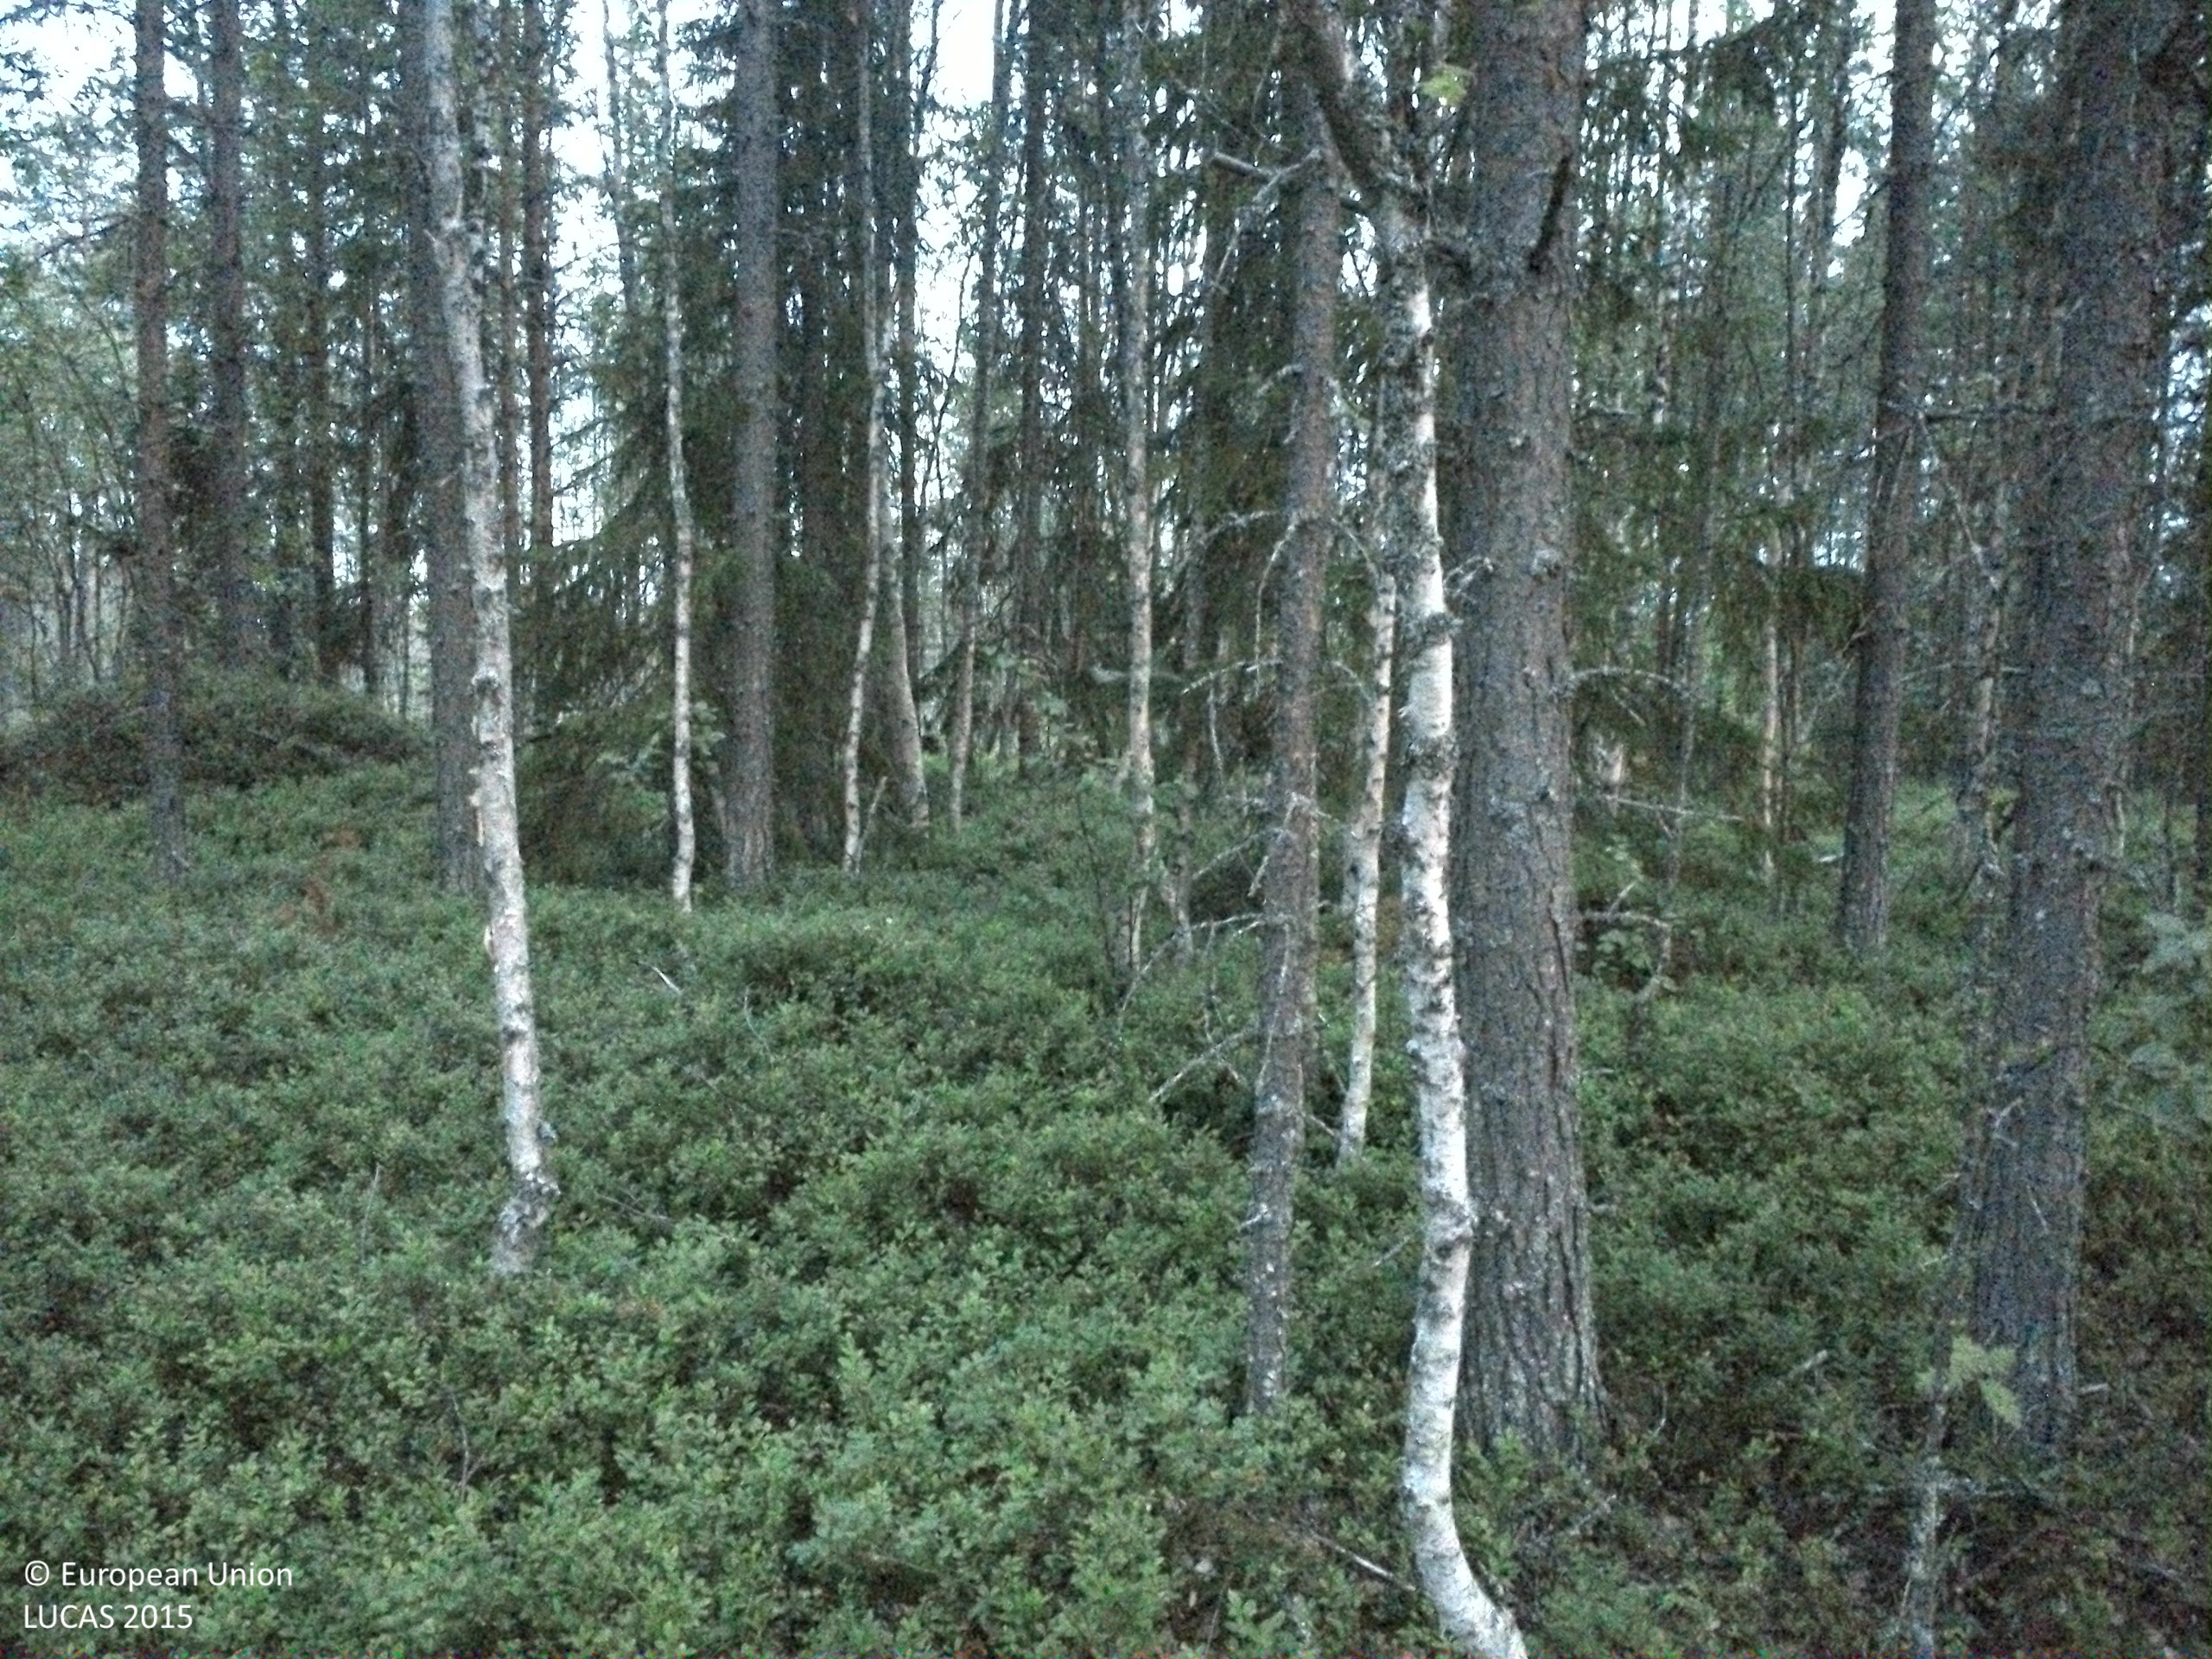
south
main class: Woodland
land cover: Pine dominated mixed woodland
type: boreal forest
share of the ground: 25 - 50 %
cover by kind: shrubs 45 %, coniferous forest trees 30 %, broadleaved forest trees 15 %, lichens and mosses 10 %
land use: Forestry
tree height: > 5 m
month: July
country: SE
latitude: 64.3526
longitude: 16.1194
